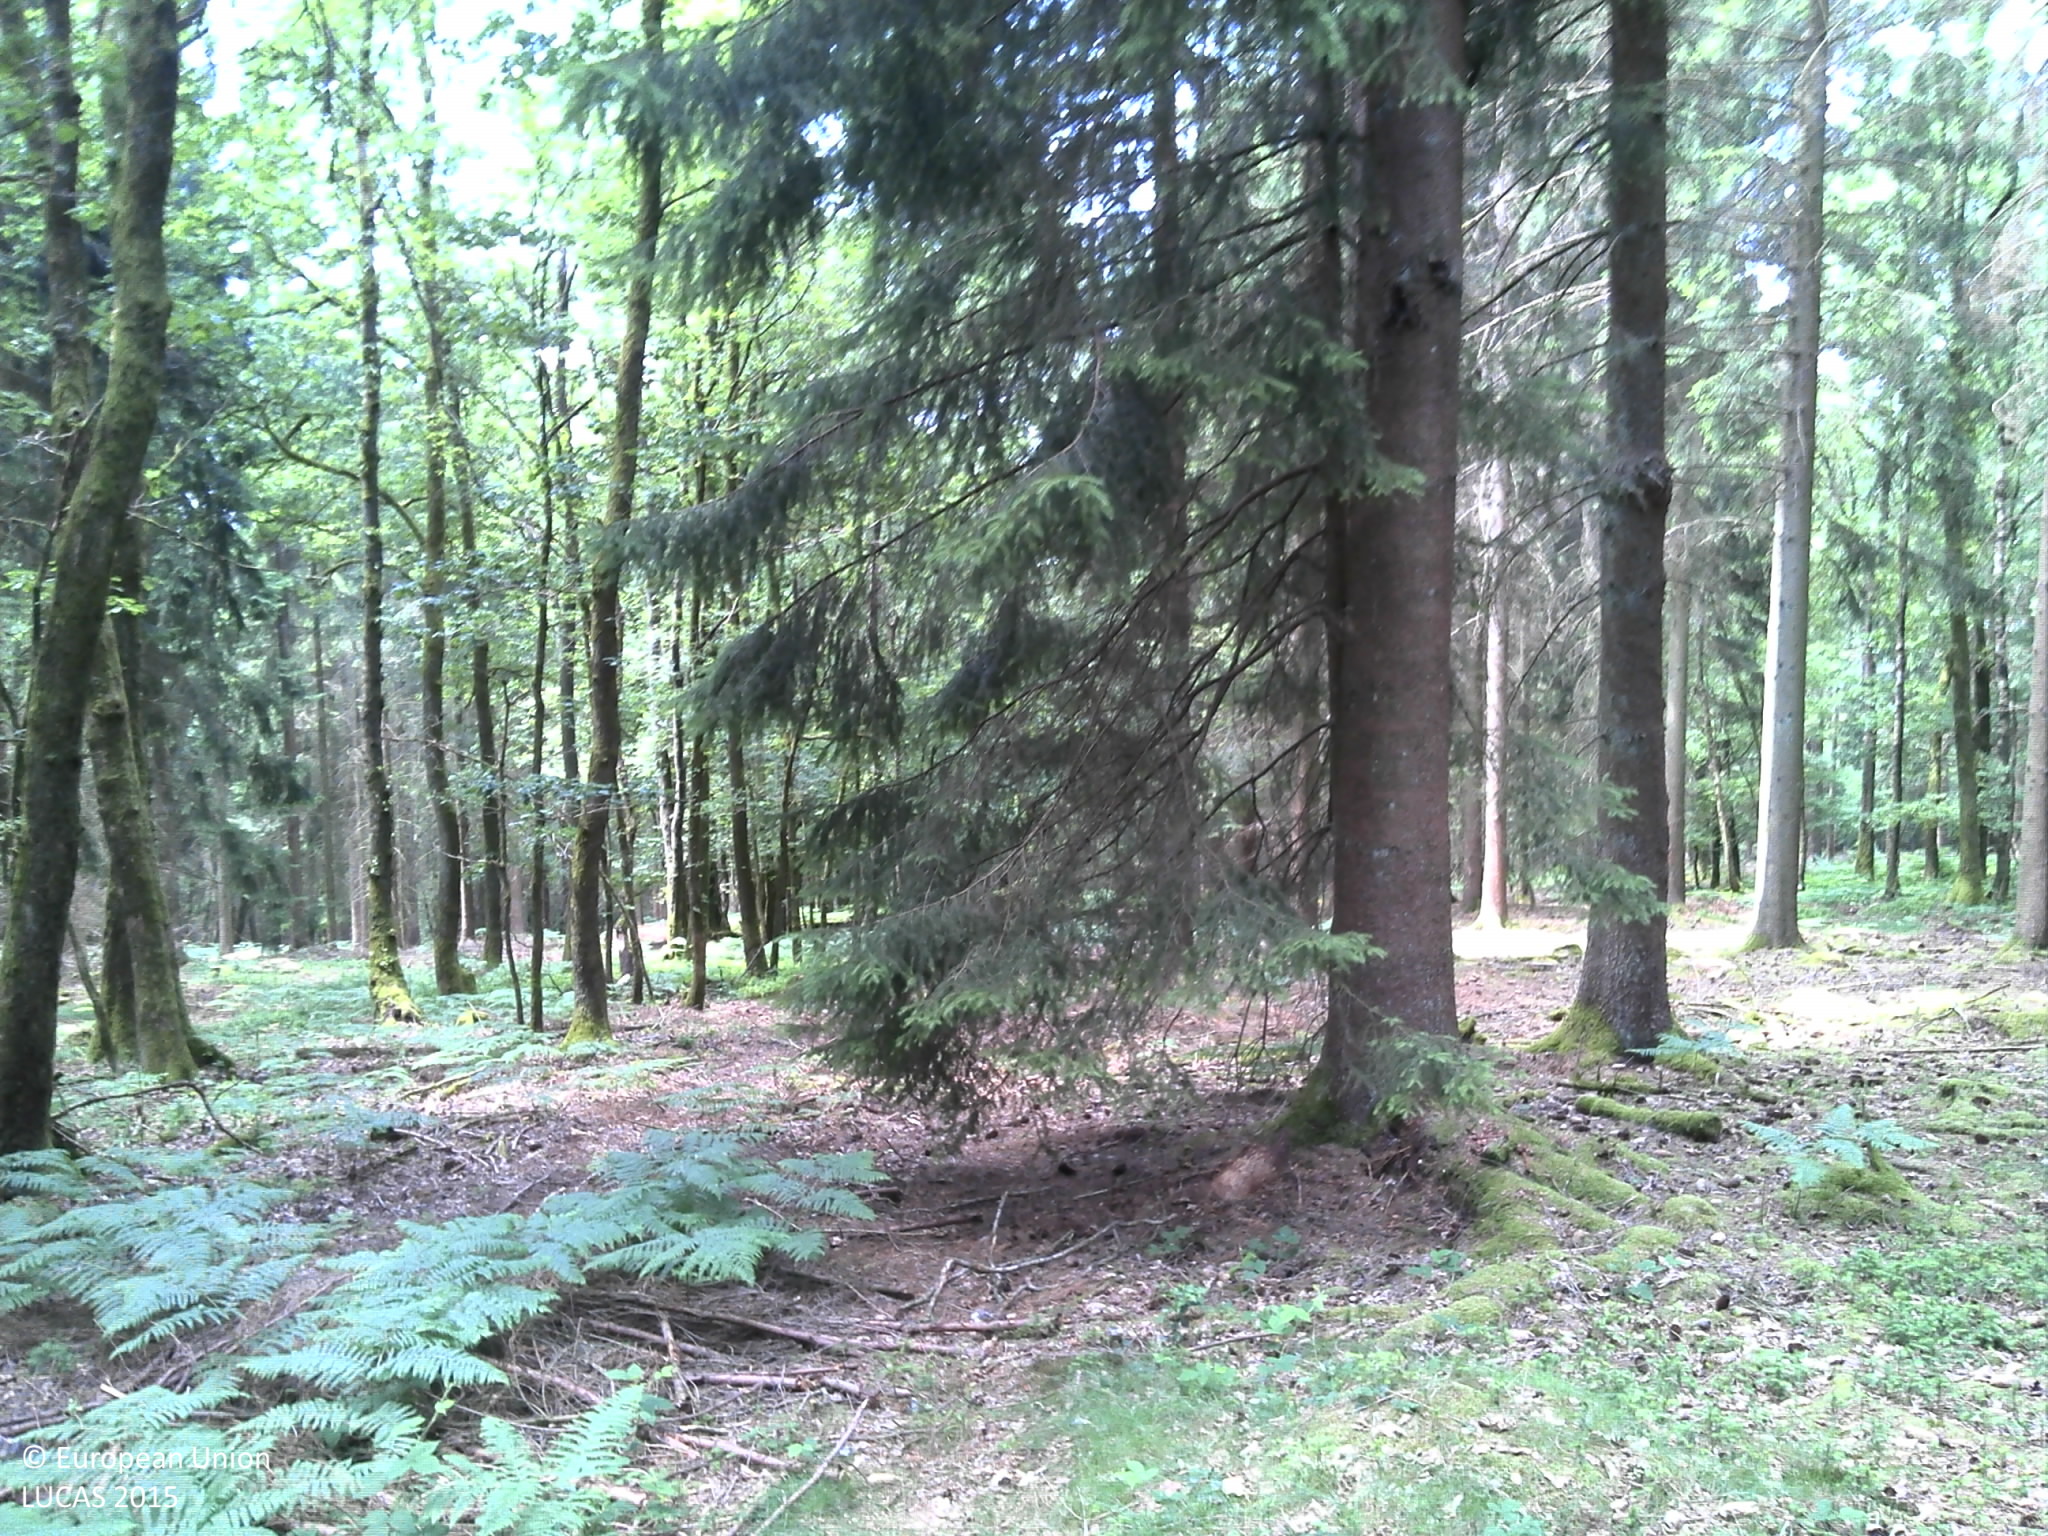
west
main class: Woodland
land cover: Spruce dominated mixed woodland
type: mountainous beech forest
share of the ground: 50 - 75 %
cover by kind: coniferous forest trees 50 %, broadleaved forest trees 25 %, herbaceous plants 10 %, lichens and mosses 10 %, consolidated bare surface 5 %
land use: Forestry
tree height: > 5 m
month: July
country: FR
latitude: 49.9177
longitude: 4.7182
